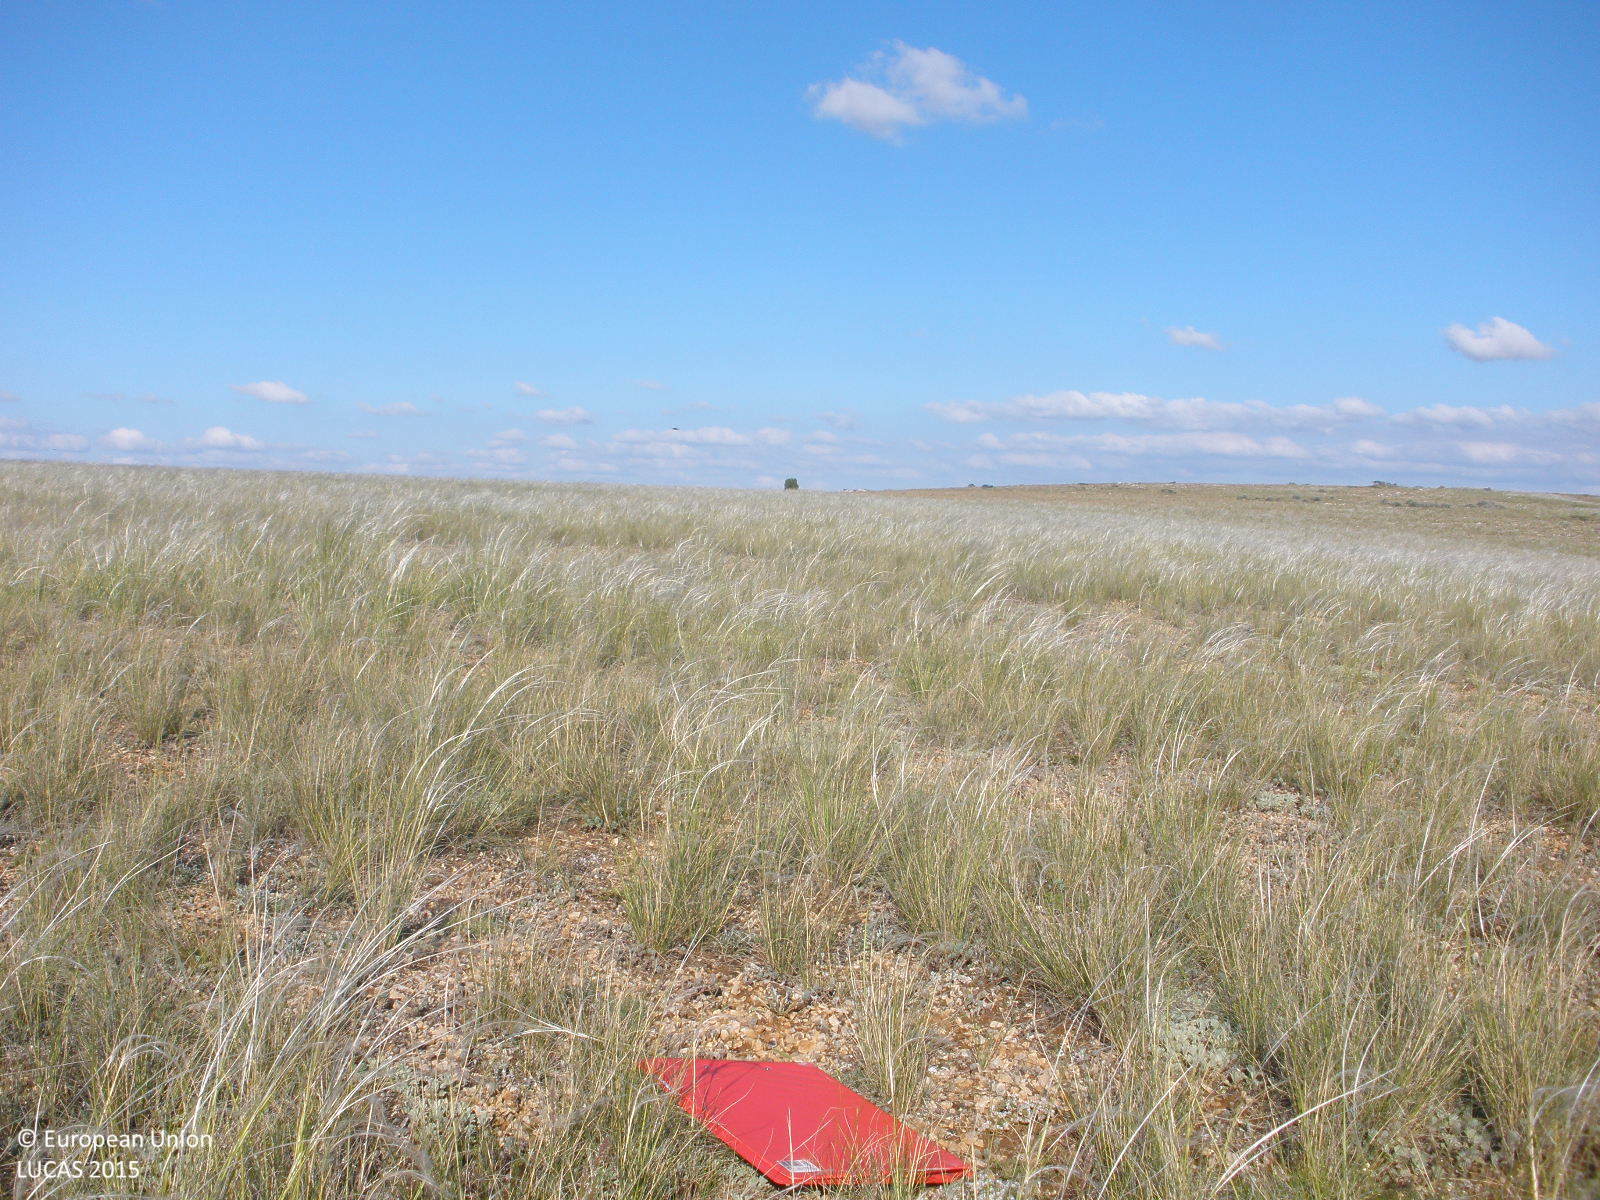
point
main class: Grassland
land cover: Grassland without tree/shrub cover
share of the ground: > 75 %
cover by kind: herbaceous plants 80 %, unconsolidated bare surface 20 %
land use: Semi-natural and natural areas not in use
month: June
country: ES
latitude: 40.5915
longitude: -0.8703
